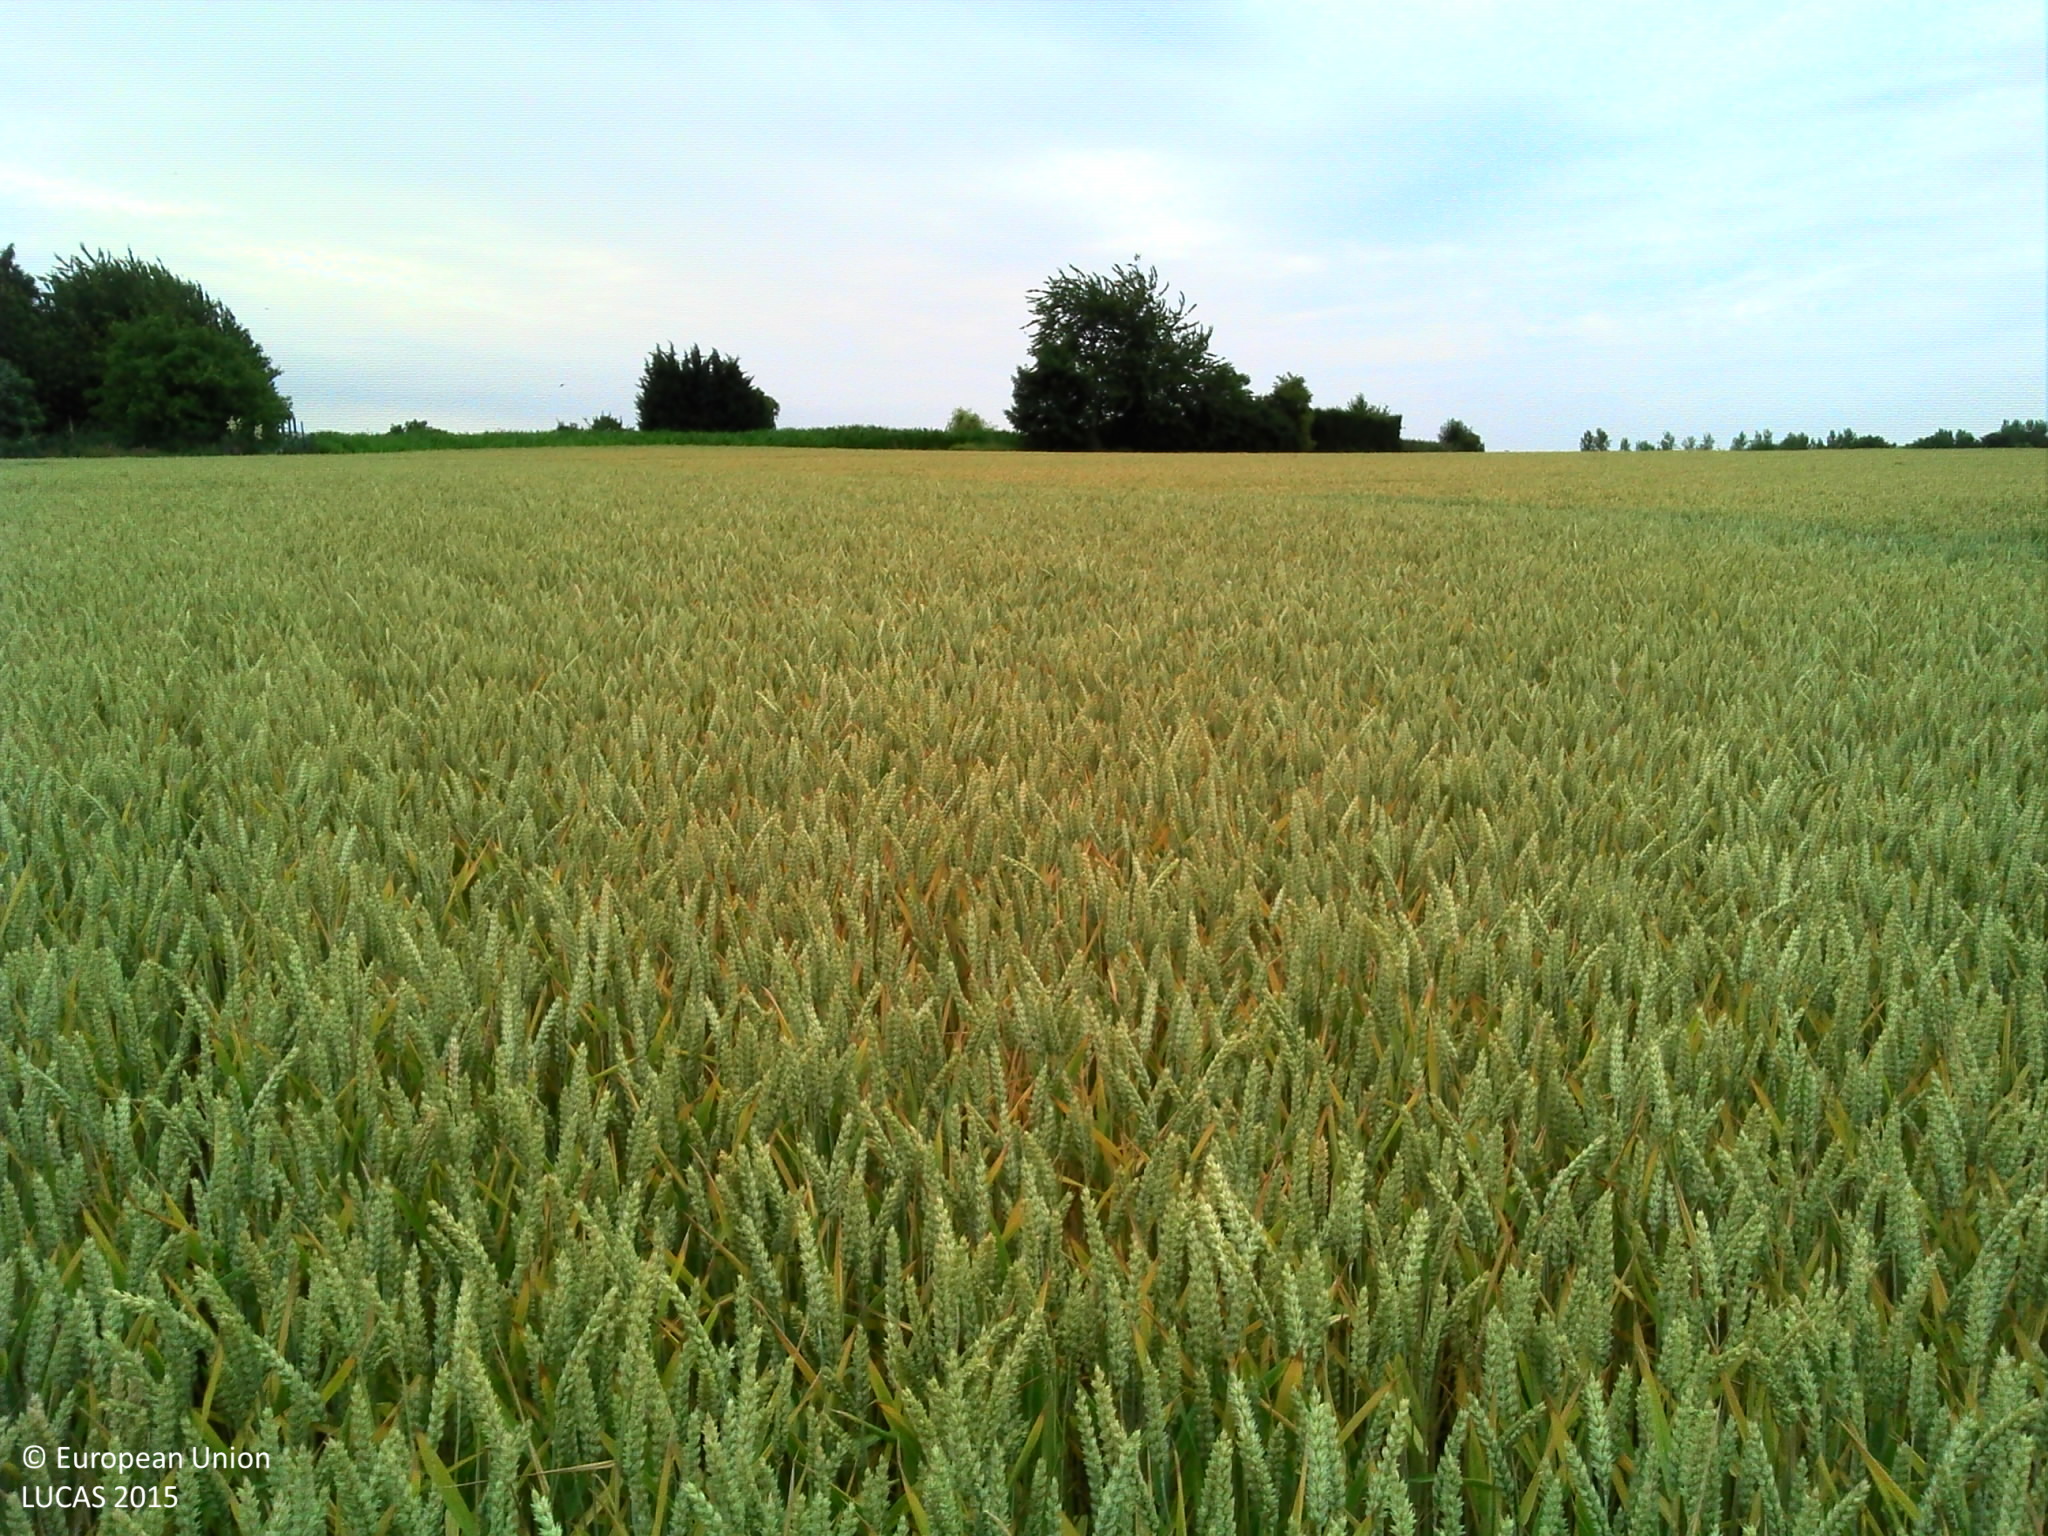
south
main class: Cropland
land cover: Common wheat
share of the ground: > 75 %
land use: Agriculture (excluding fallow land and kitchen gardens)
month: July
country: FR
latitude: 50.4418
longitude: 2.7653
